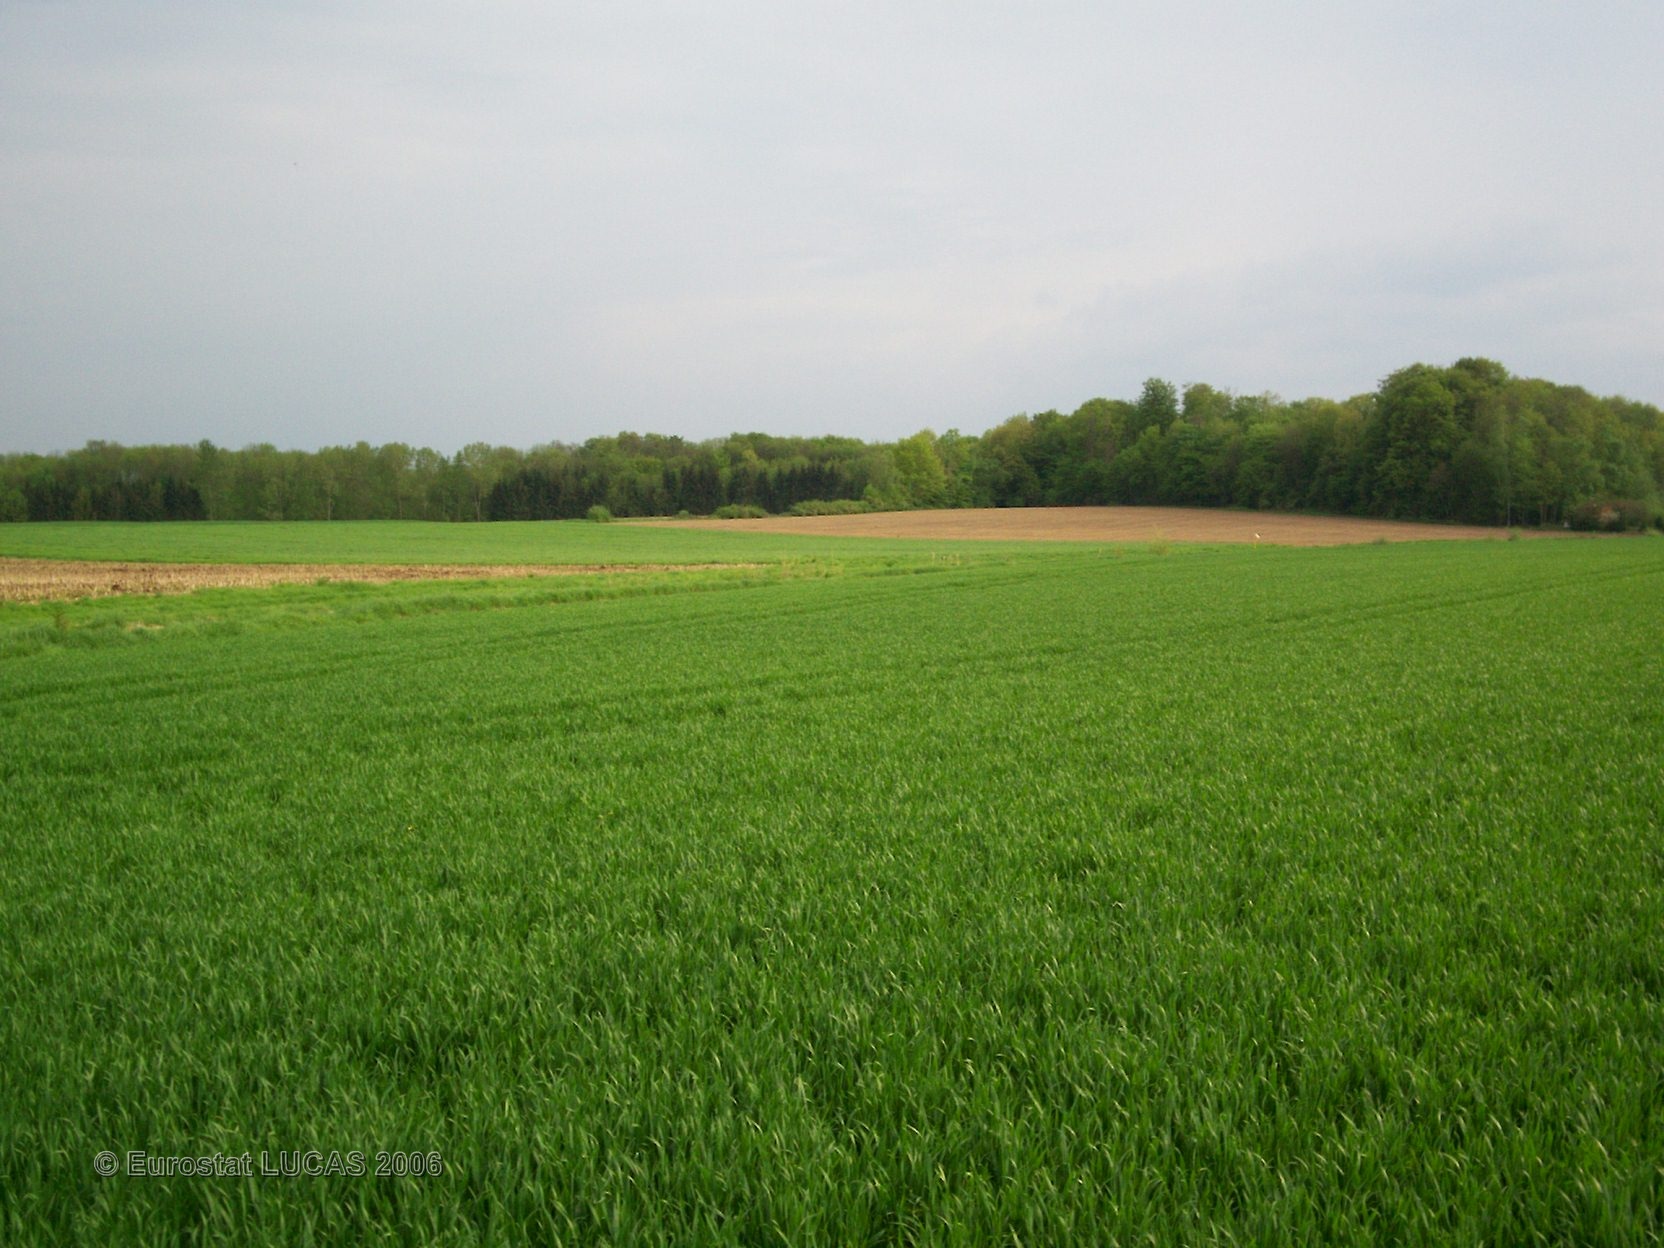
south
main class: Cropland
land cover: Common wheat
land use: Agriculture (excluding fallow land and kitchen gardens)
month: May
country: FR
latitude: 47.5736
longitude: 7.1169
